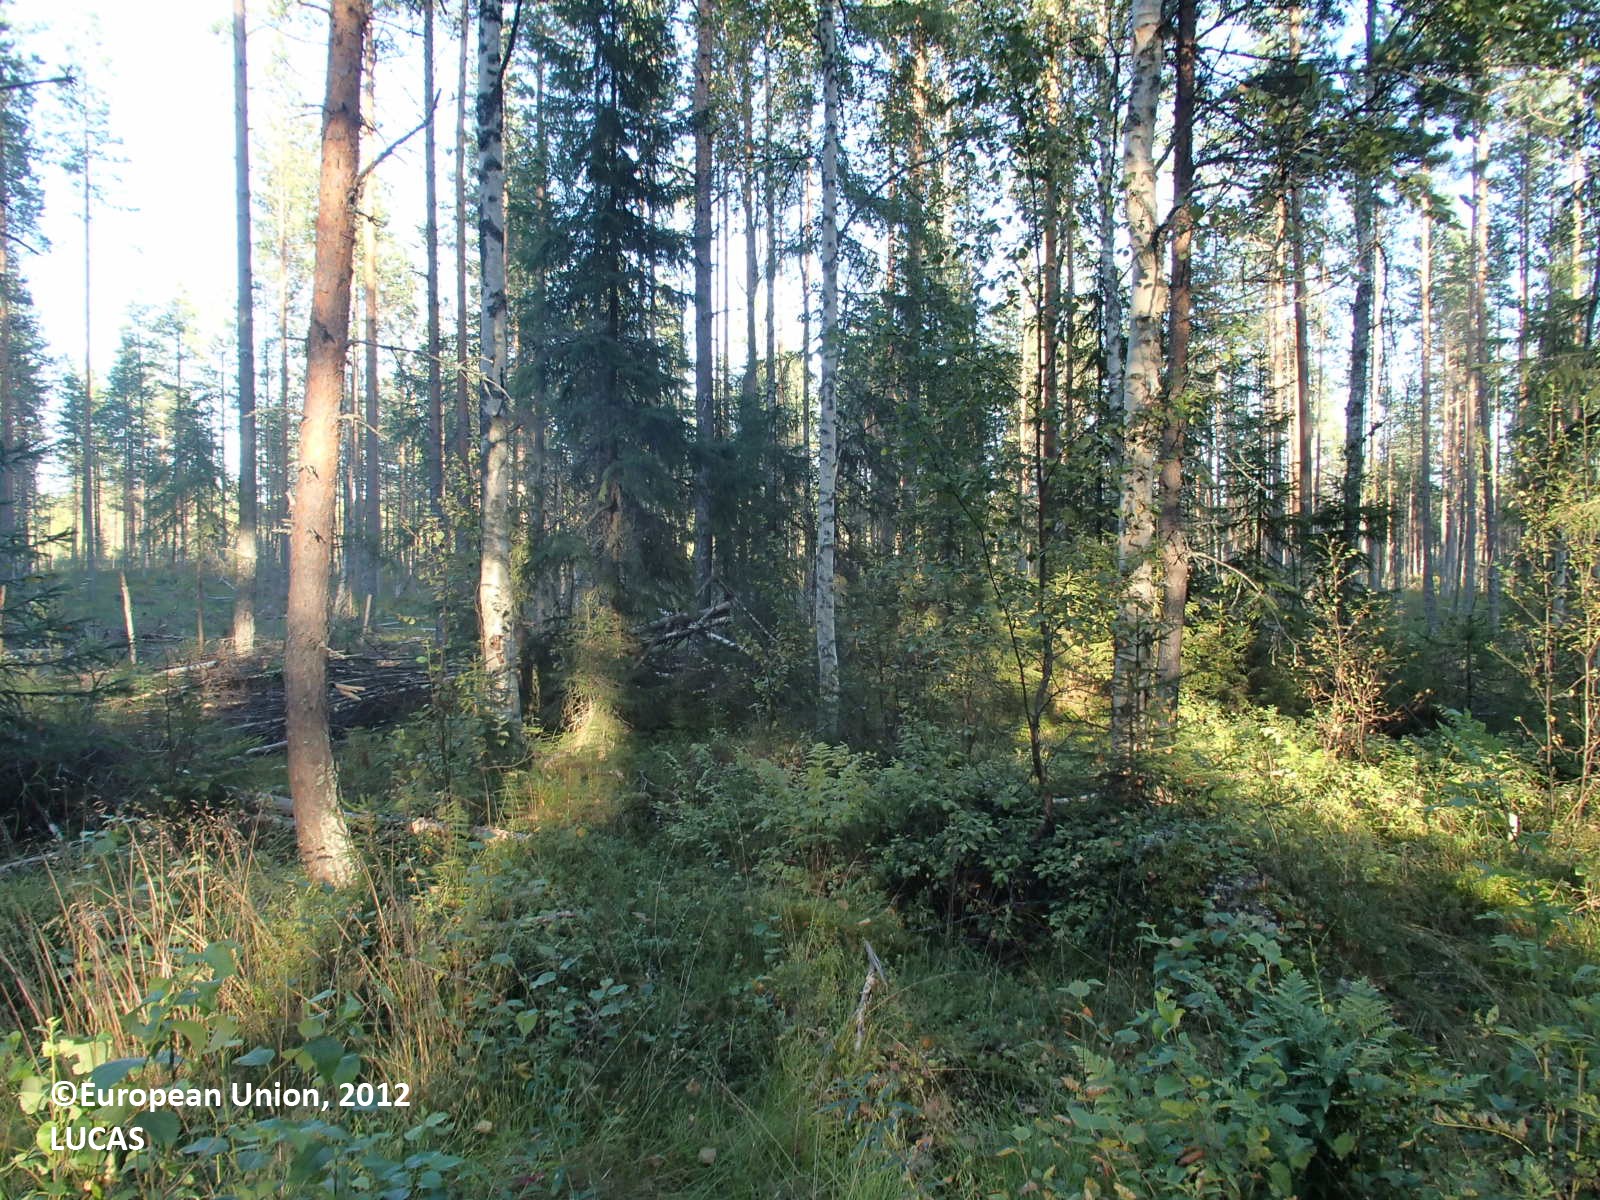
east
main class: Woodland
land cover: Pine dominated mixed woodland
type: boreal forest
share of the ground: 50 - 75 %
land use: Forestry
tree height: > 5 m
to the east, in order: Pine dominated mixed woodland; Ditches and canals; Pine dominated coniferous woodland; Ditches and canals; Pine dominated coniferous woodland; Ditches and canals; Pine dominated coniferous woodland; Ditches and canals; Pine dominated coniferous woodland; Ditches and canals; Pine dominated coniferous woodland; Pine dominated mixed woodland; Ditches and canals
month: August
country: FI
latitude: 63.4999
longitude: 28.0311
